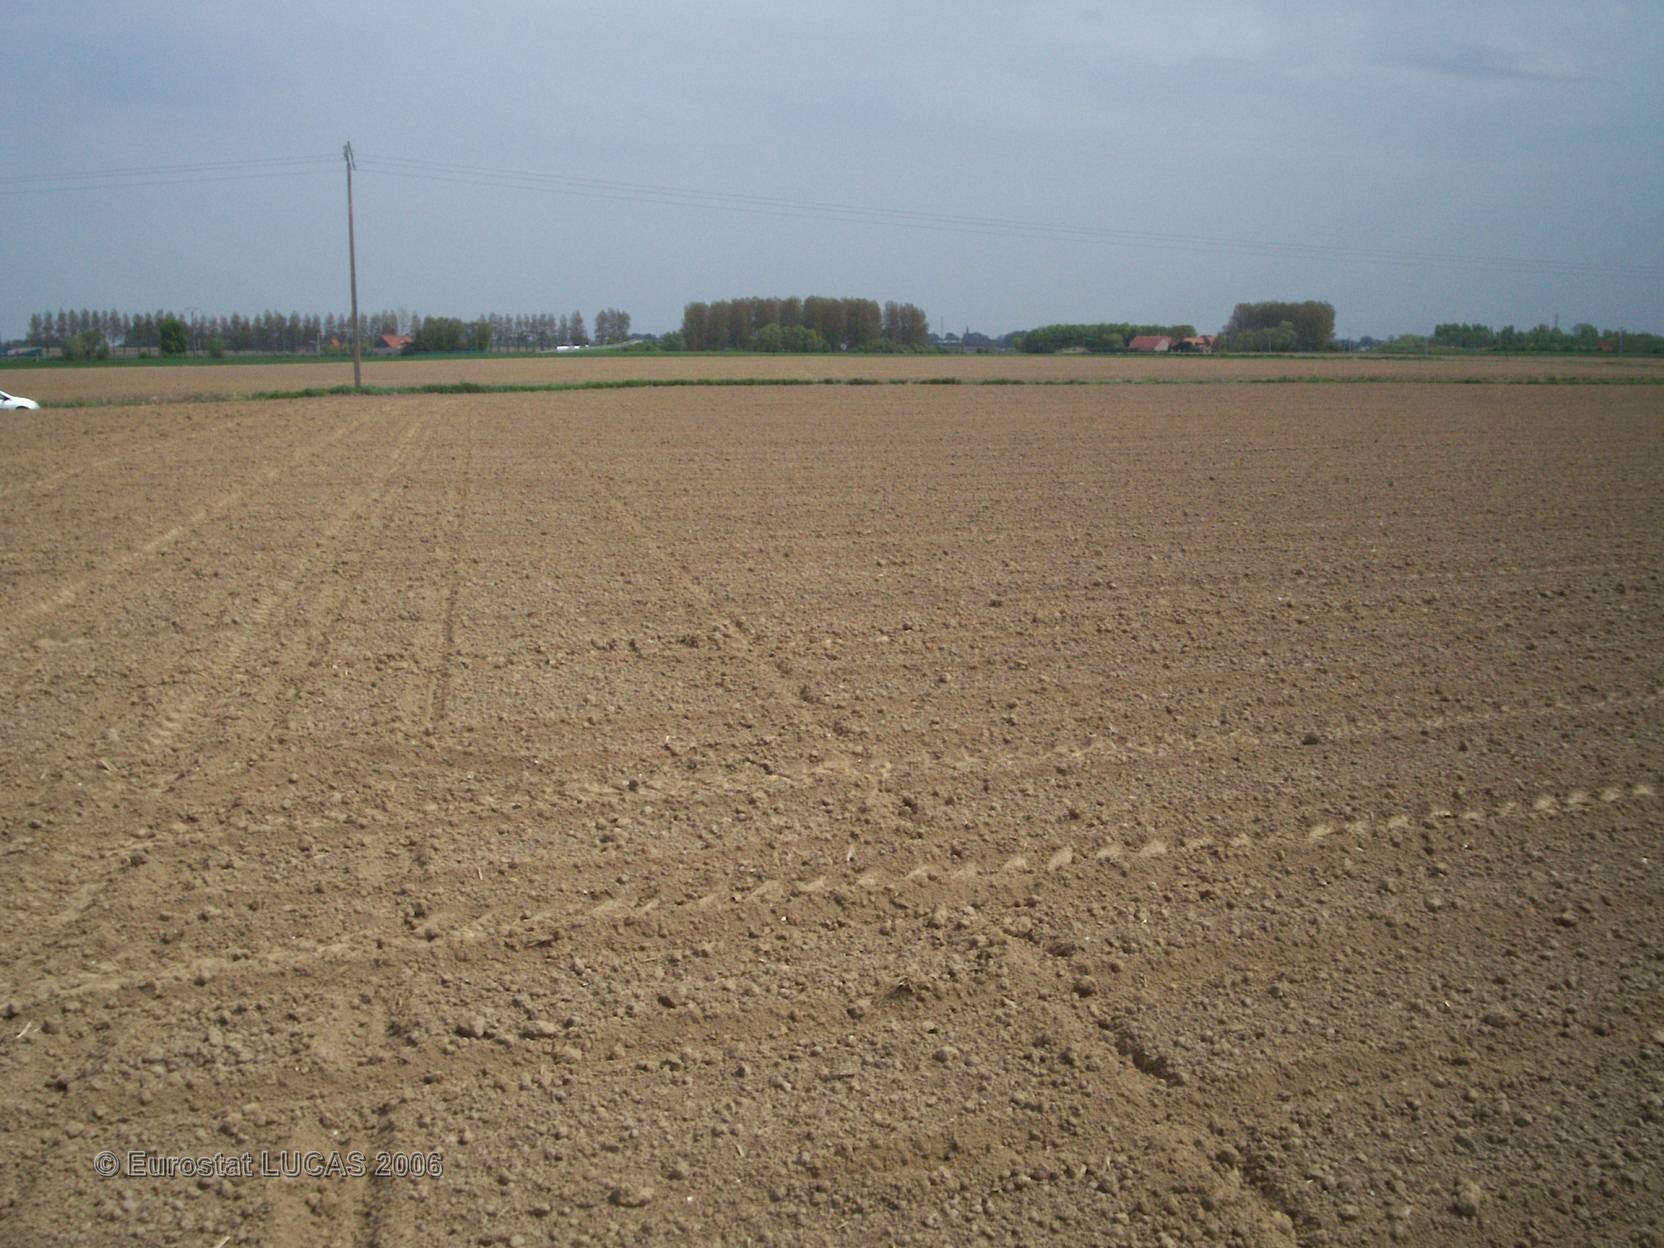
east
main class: Cropland
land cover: Maize
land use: Agriculture (excluding fallow land and kitchen gardens)
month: May
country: FR
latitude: 50.9277
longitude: 2.4606
